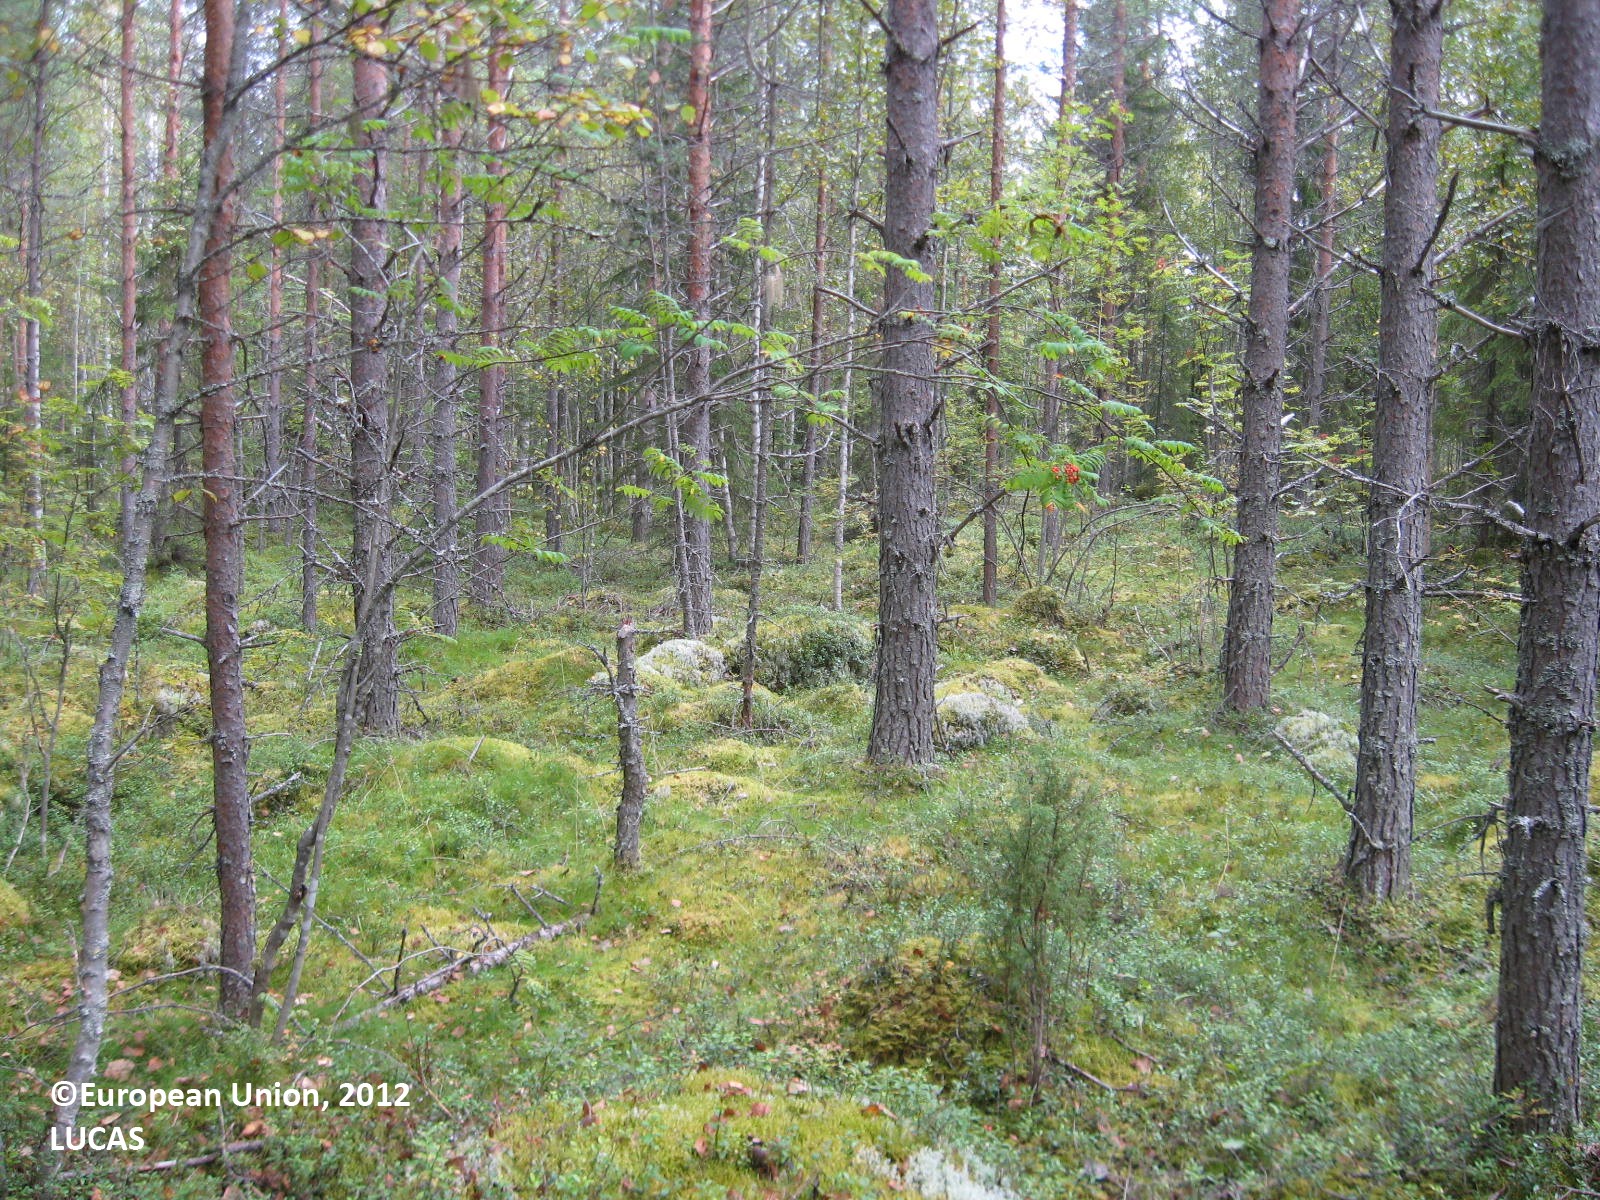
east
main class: Woodland
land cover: Pine dominated coniferous woodland
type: boreal forest
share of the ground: > 75 %
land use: Forestry
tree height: > 5 m
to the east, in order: Pine dominated coniferous woodland; Other mixed woodland; Ditches and canals; Other mixed woodland; Ditches and canals; Other mixed woodland; Broadleaved woodland
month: August
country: FI
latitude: 63.6138
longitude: 29.2337
